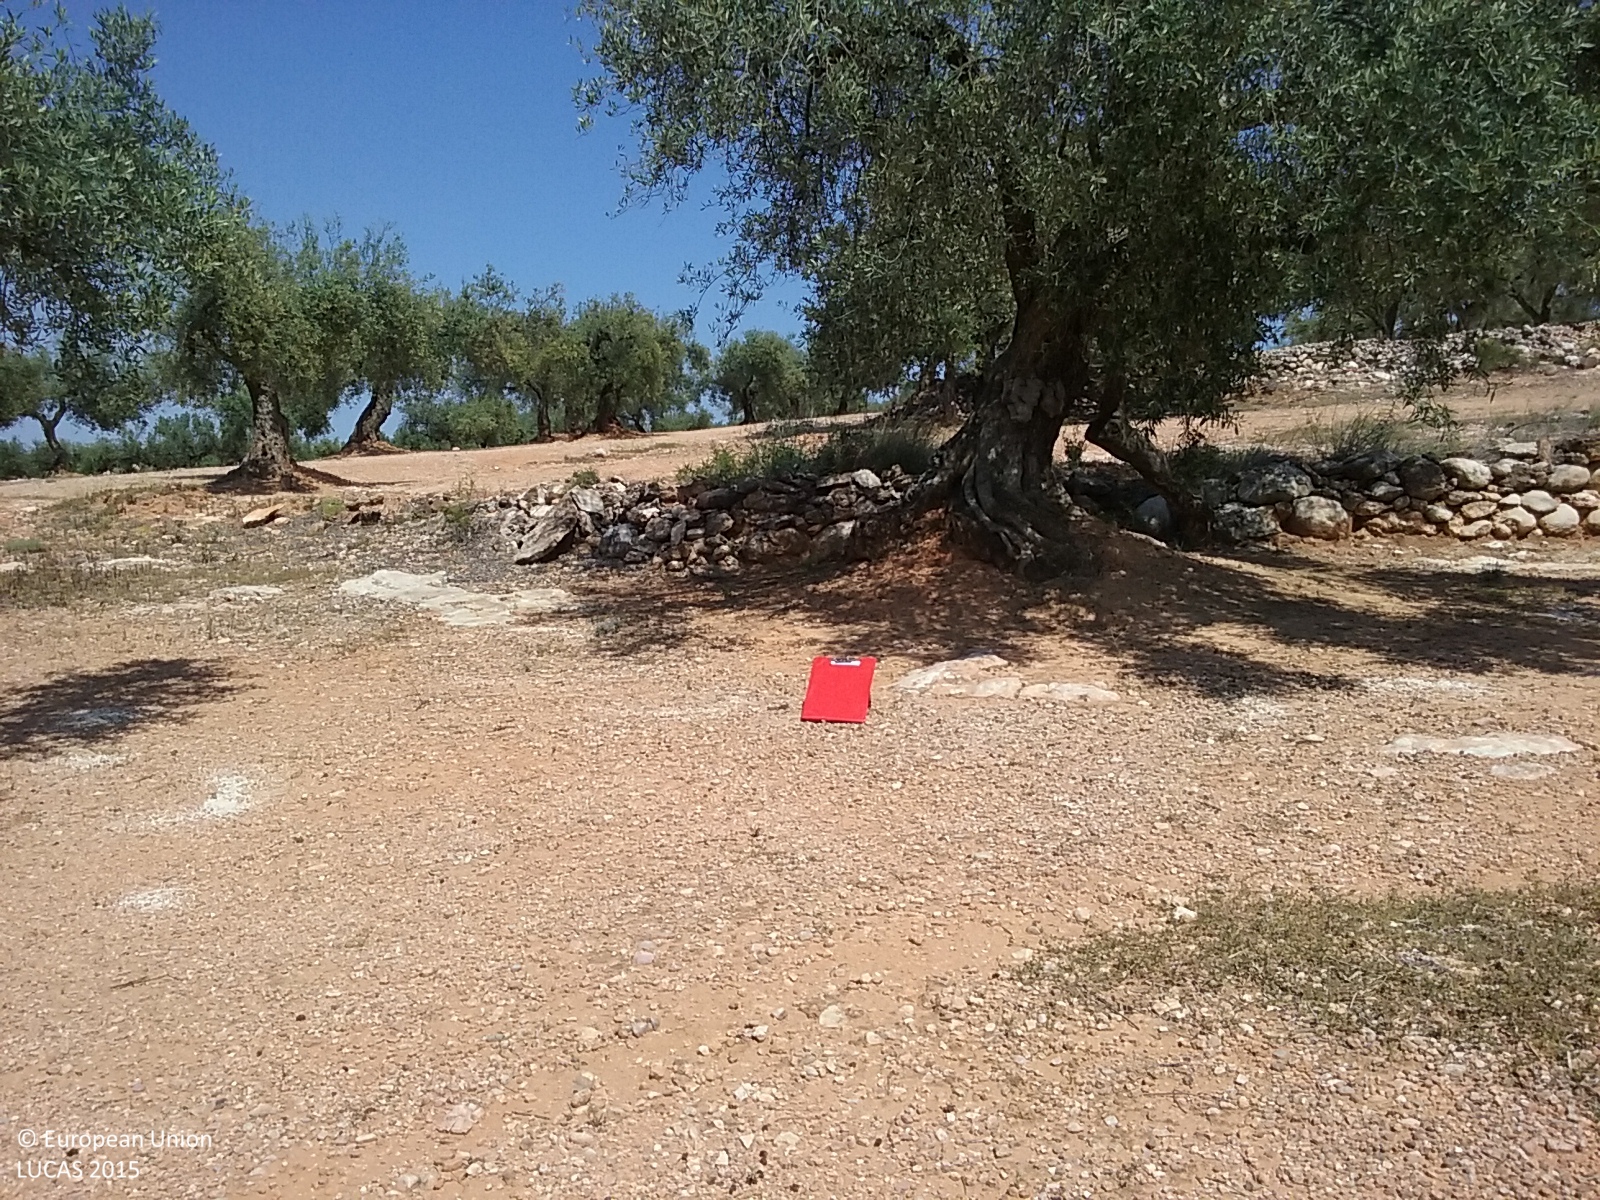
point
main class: Cropland
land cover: Olive groves
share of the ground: 25 - 50 %
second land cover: Other bare soil
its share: > 75 %
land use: Agriculture (excluding fallow land and kitchen gardens)
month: May
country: ES
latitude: 40.5660
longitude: 0.2742
